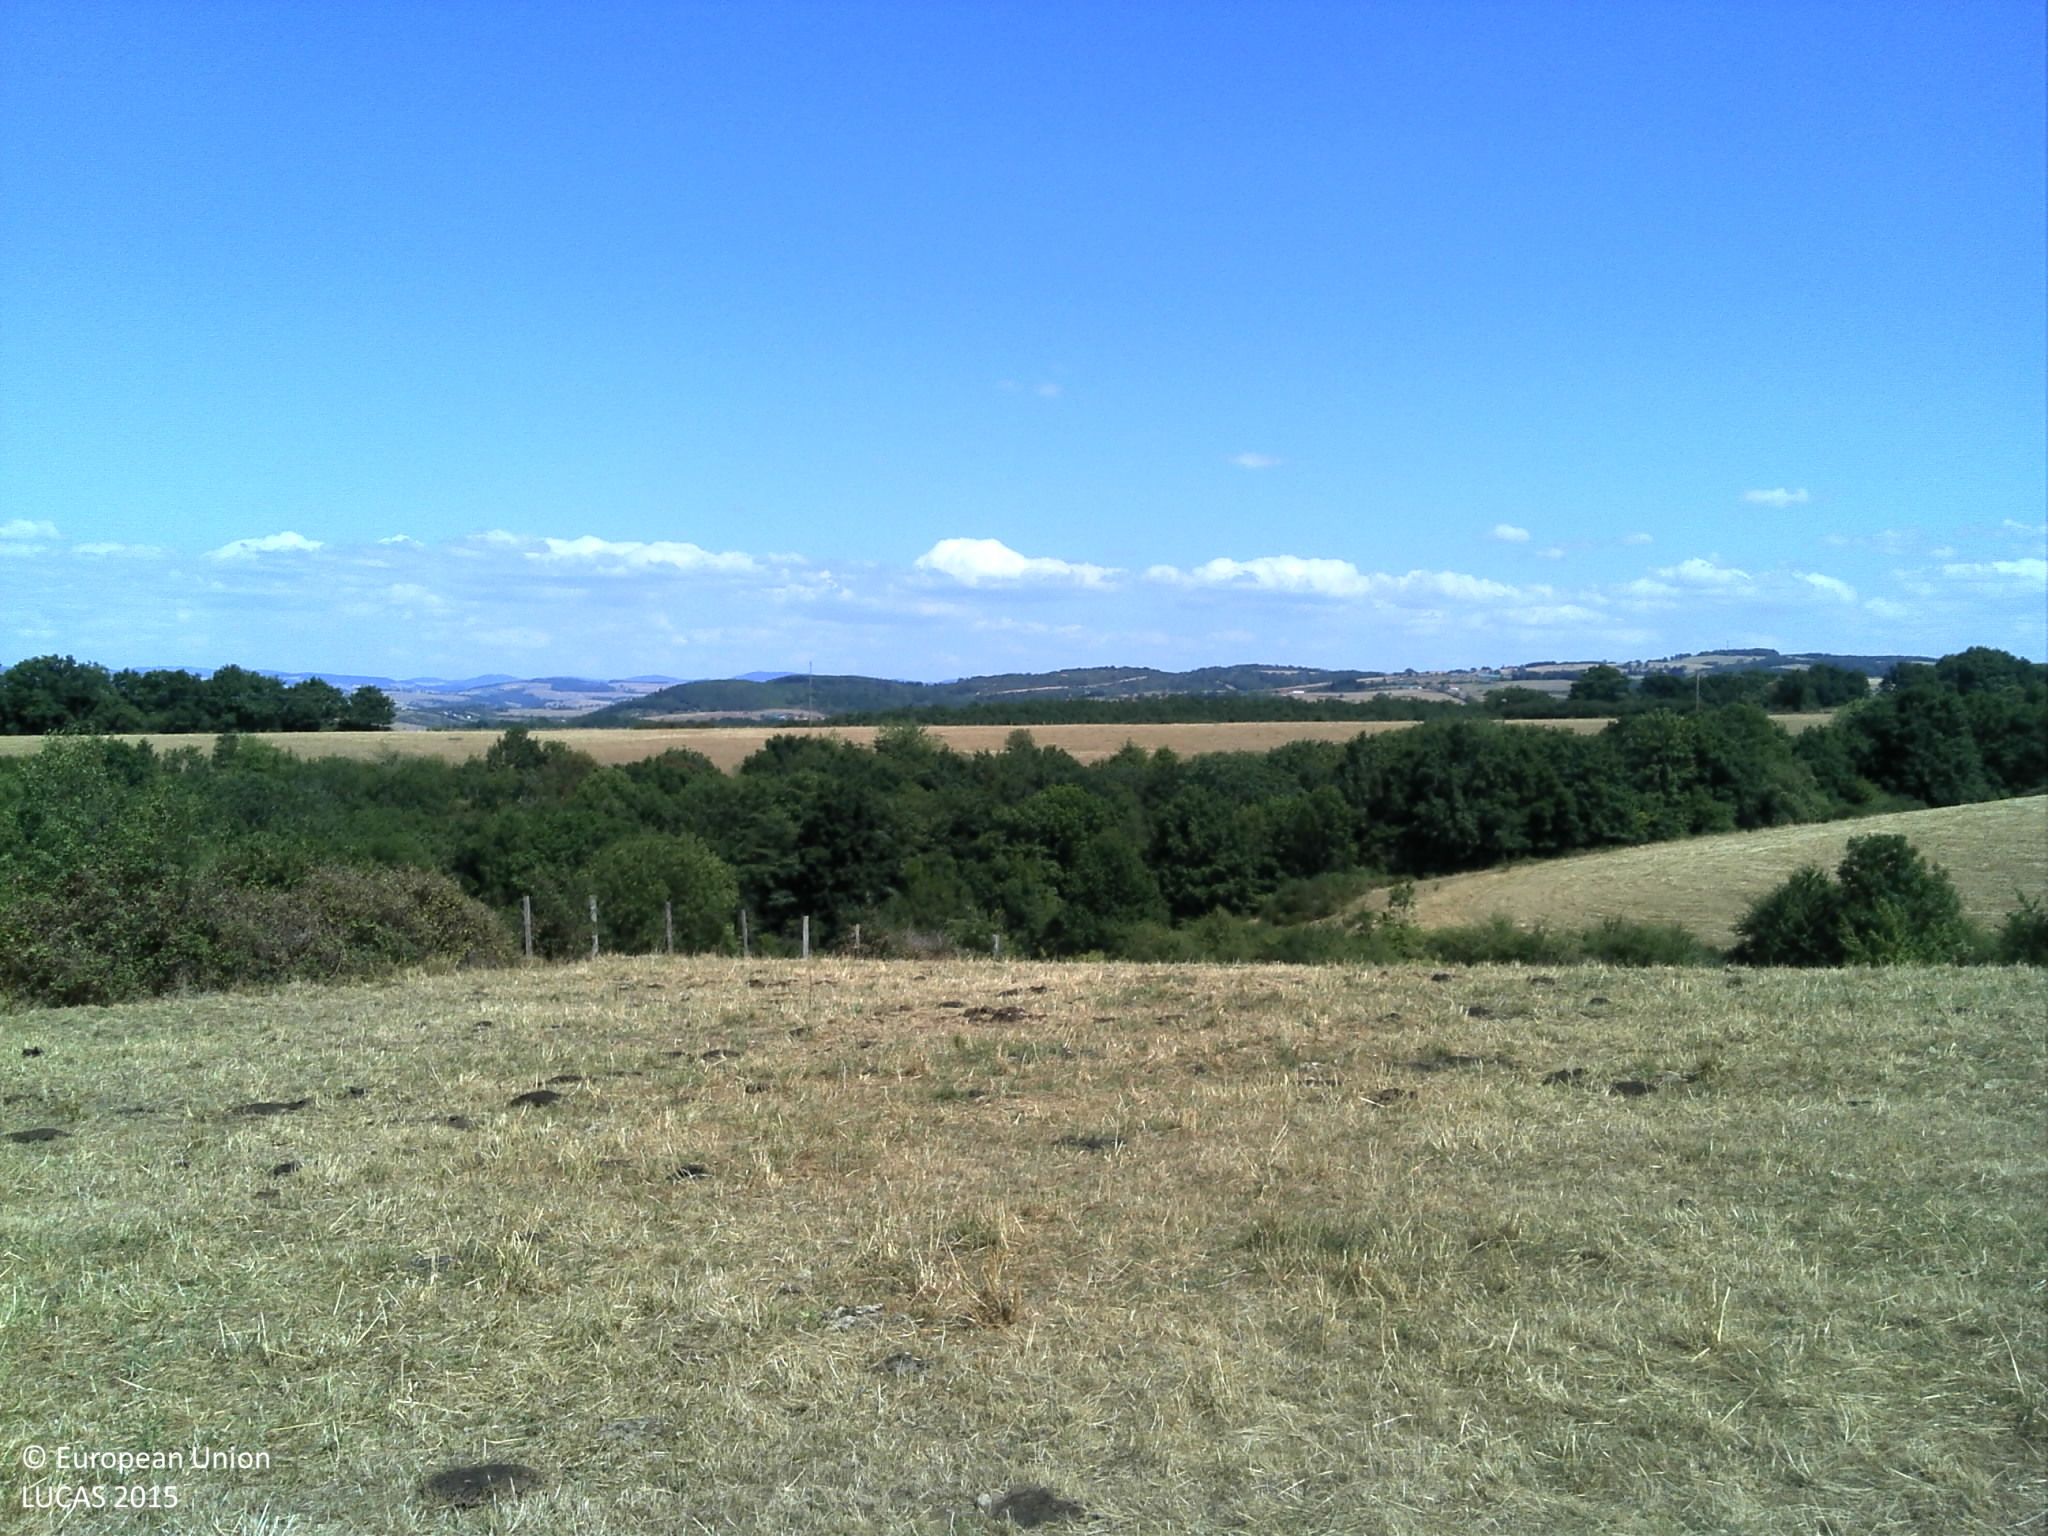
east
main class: Grassland
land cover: Grassland without tree/shrub cover
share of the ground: > 75 %
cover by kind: herbaceous plants 100 %
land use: Agriculture (excluding fallow land and kitchen gardens)
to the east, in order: Grassland without tree/shrub cover; Fences; Tracks; Grassland without tree/shrub cover; Spontaneously vegetated surfaces; Fences; Broadleaved woodland; Ditches and canals; Broadleaved woodland
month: July
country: FR
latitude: 45.9539
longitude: 4.1058
